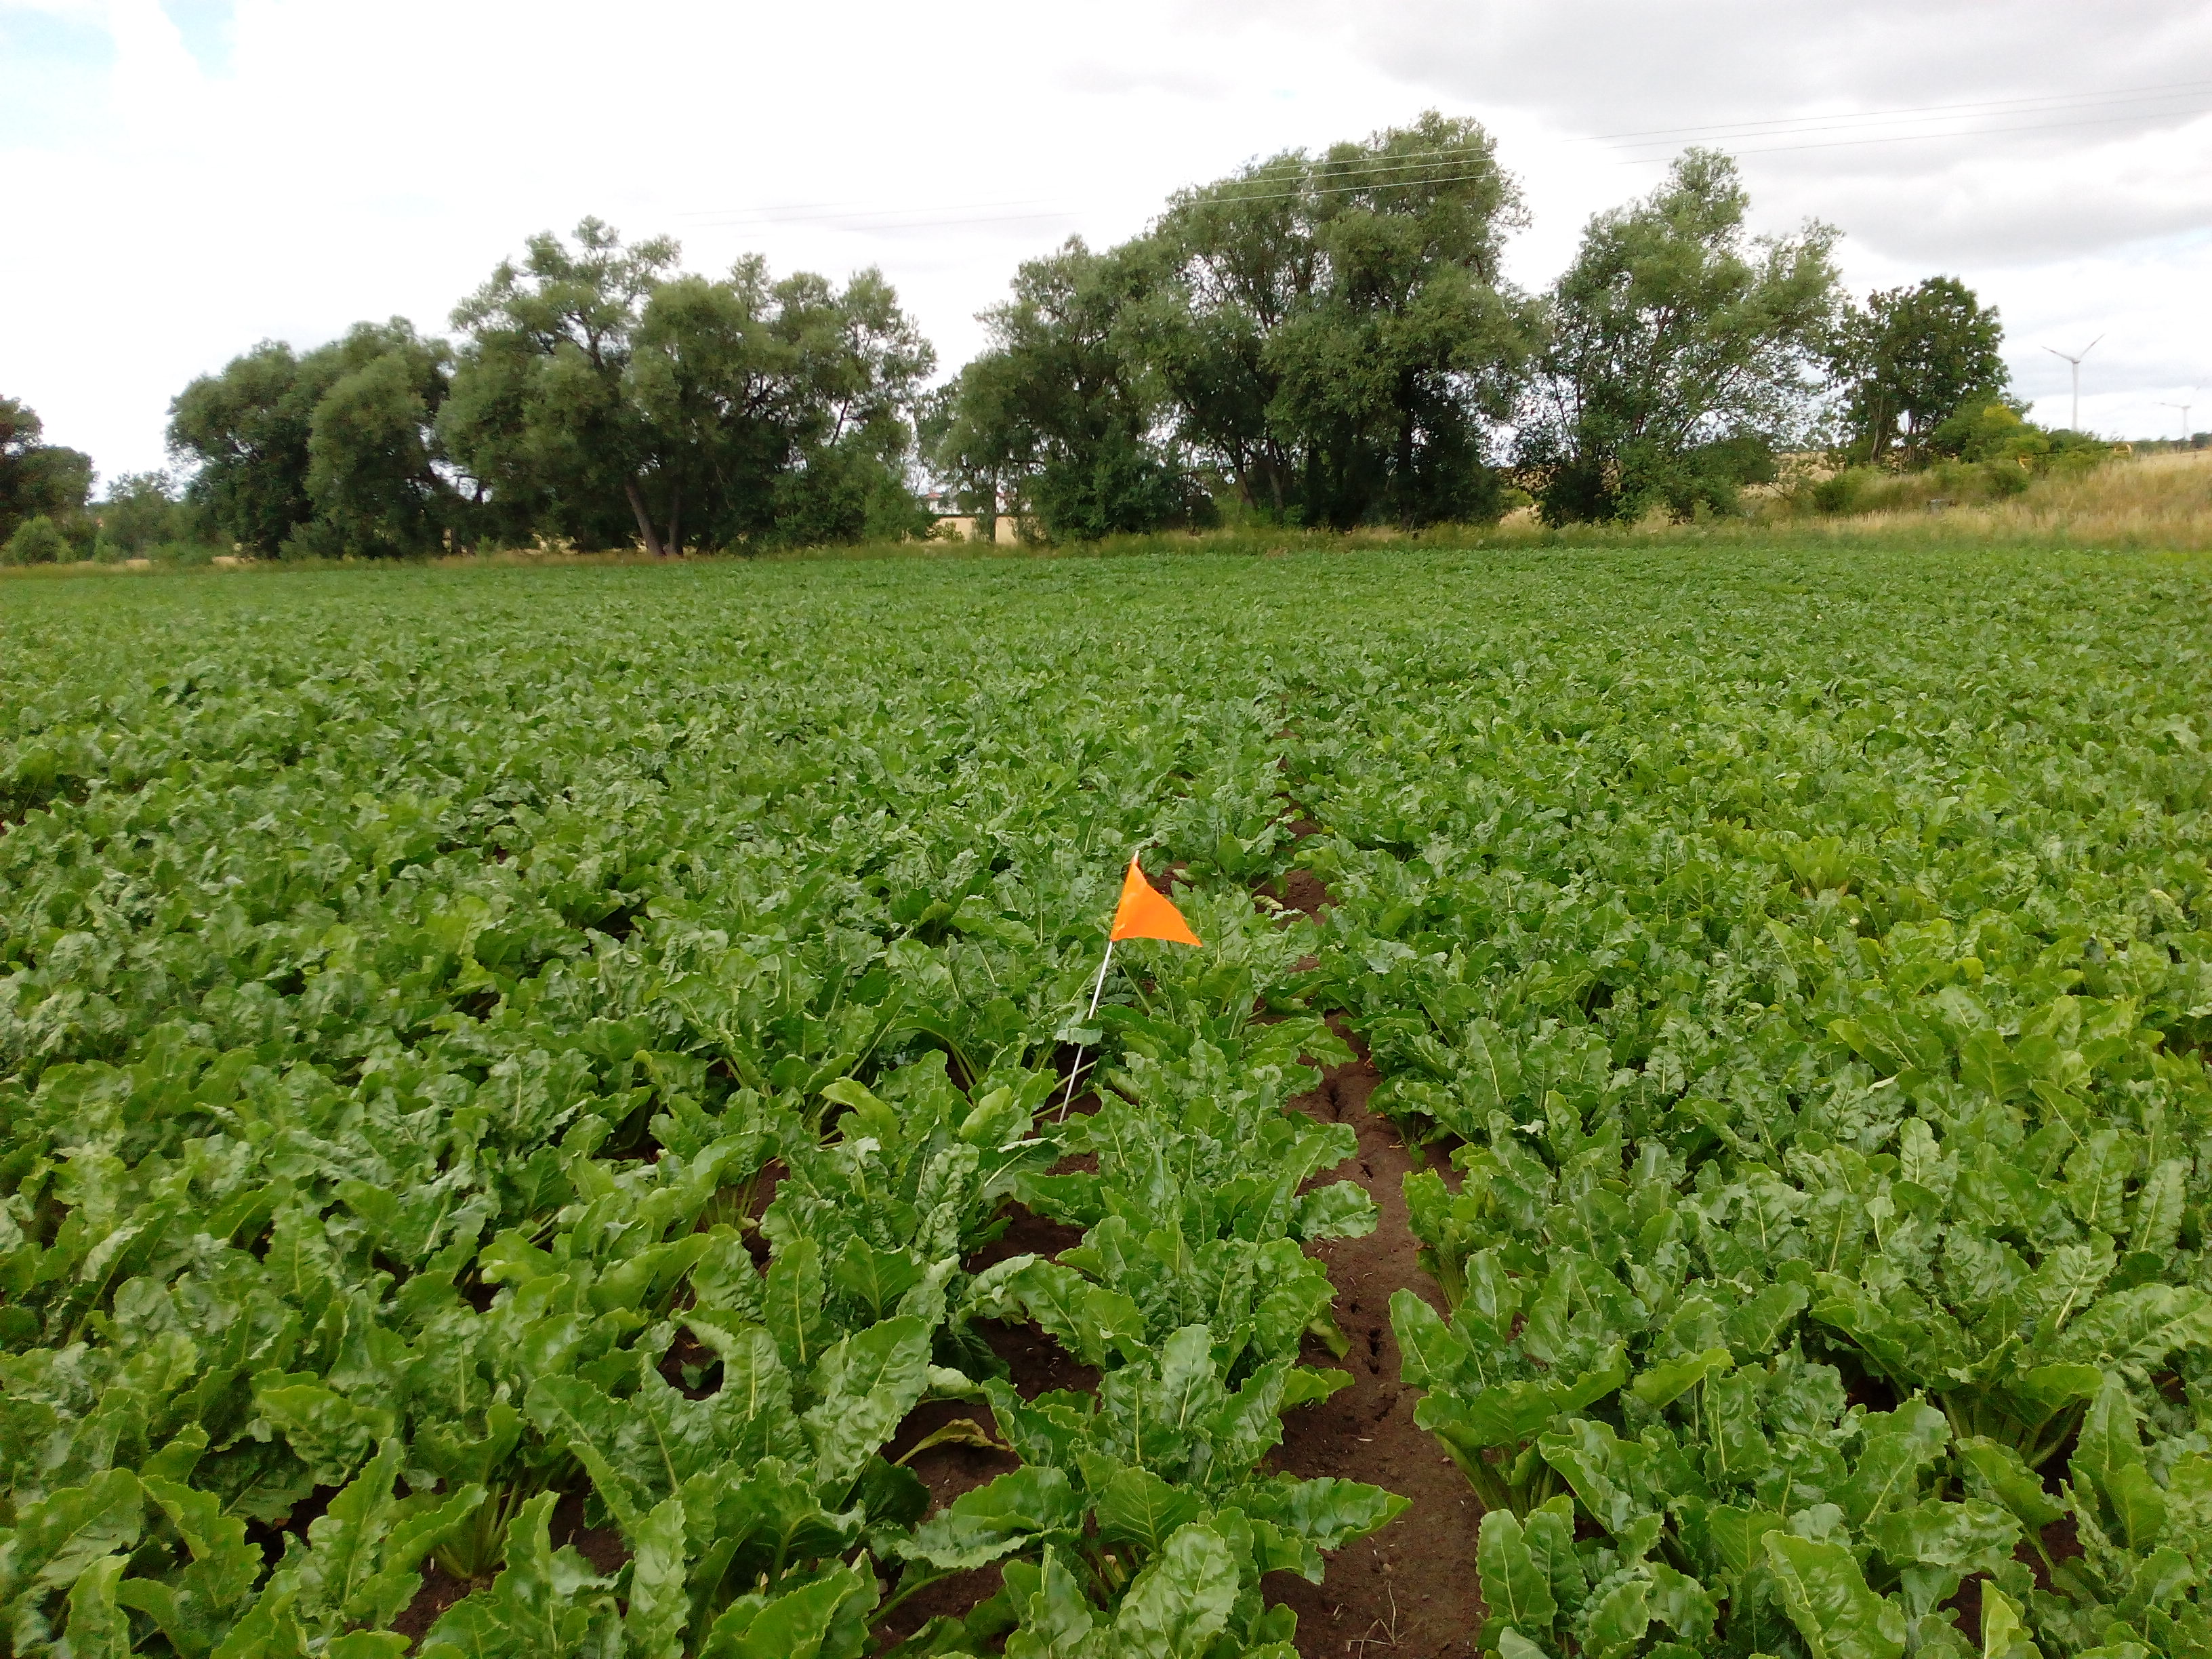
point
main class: Cropland
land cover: Sugar beet
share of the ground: > 75 %
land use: Agriculture (excluding fallow land and kitchen gardens)
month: July
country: DE
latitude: 51.1871
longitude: 10.9583
